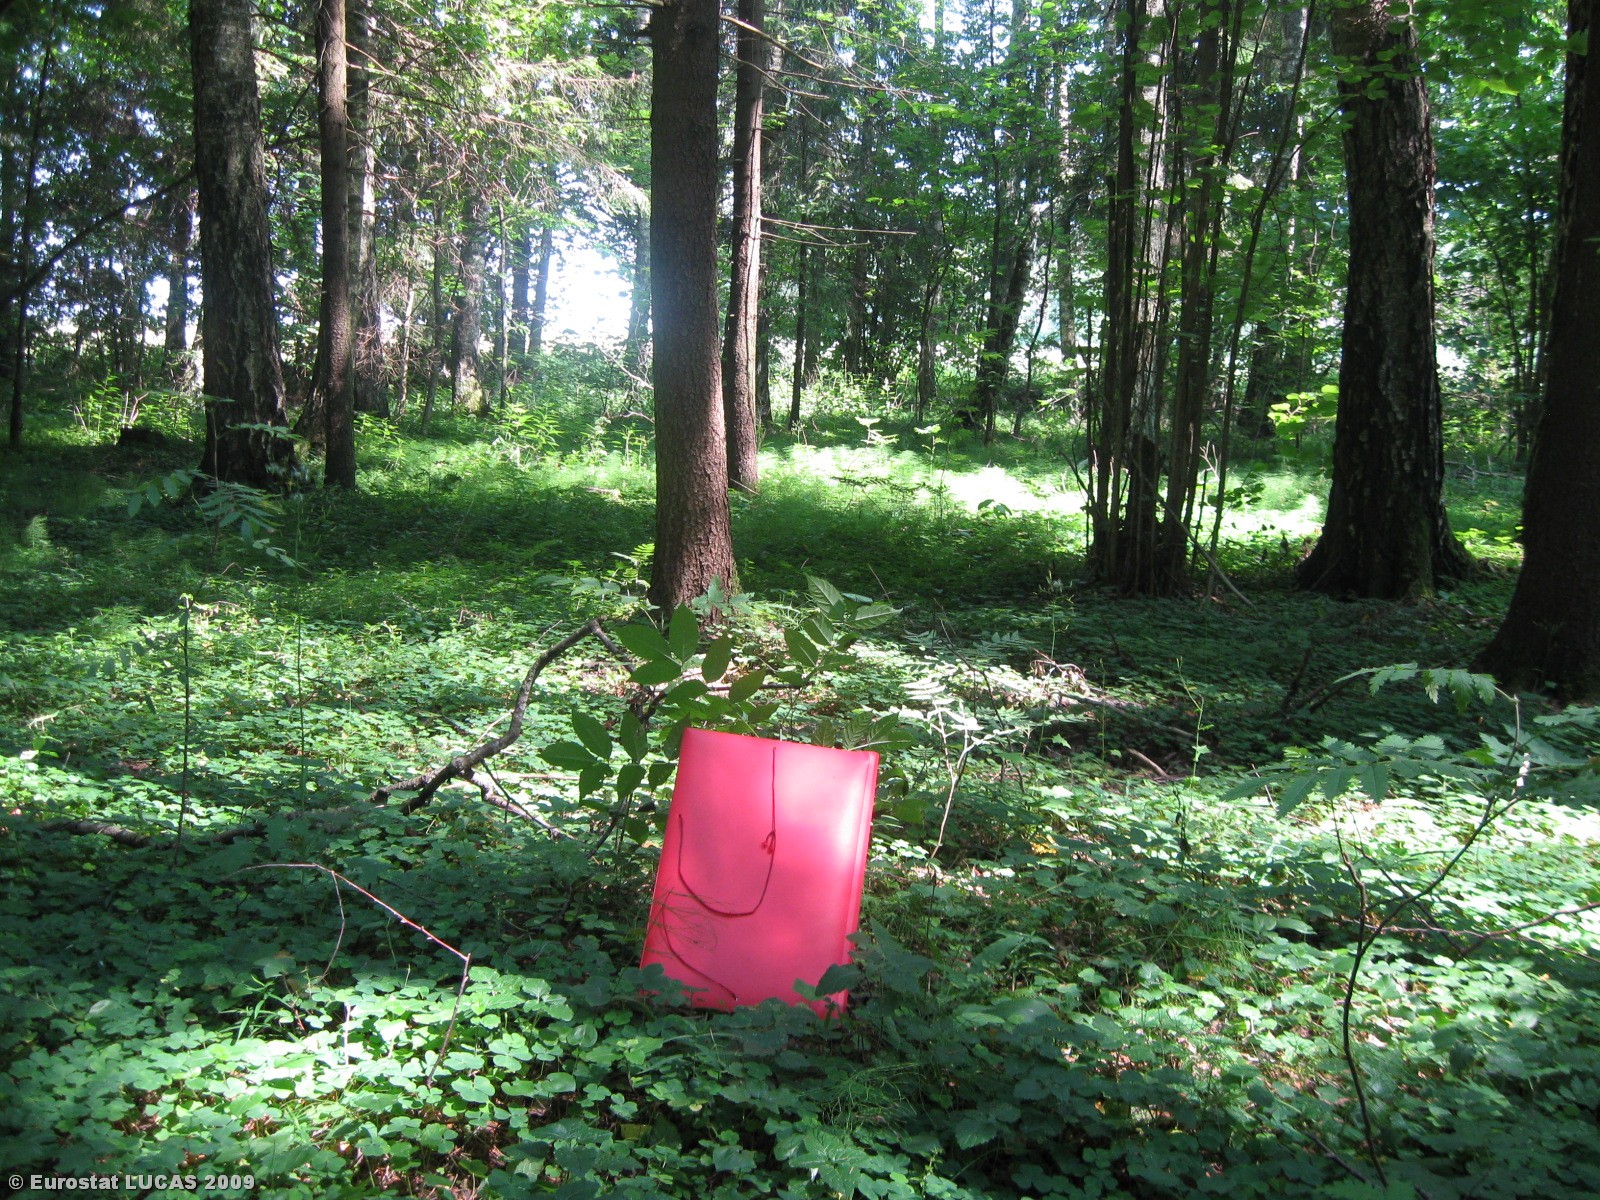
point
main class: Woodland
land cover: Mixed woodland
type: hemiboreal forest and nemoral coniferous forest and mixed broadleaved-coniferous forest
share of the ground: > 75 %
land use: Forestry
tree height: > 5 m
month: July
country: LT
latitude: 54.4448
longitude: 25.0905
